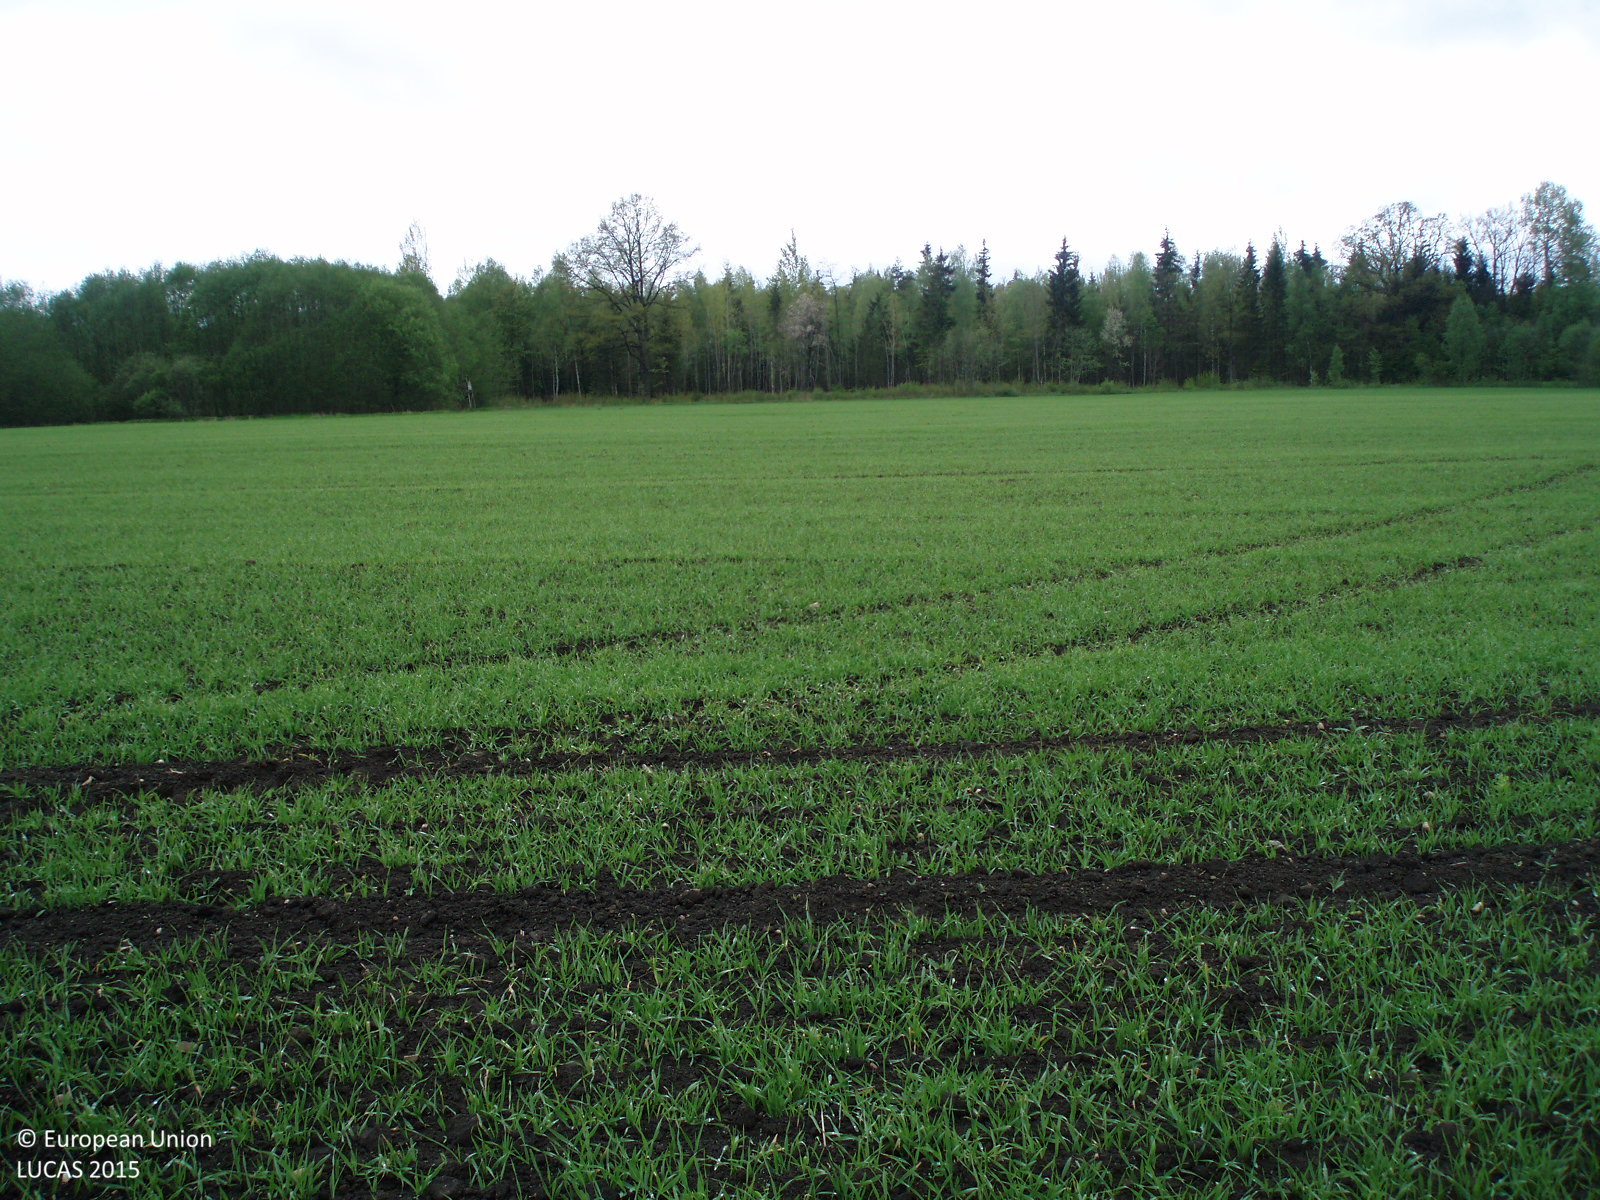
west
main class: Cropland
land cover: Barley
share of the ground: 50 - 75 %
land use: Agriculture (excluding fallow land and kitchen gardens)
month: May
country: LT
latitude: 56.3327
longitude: 22.5616
